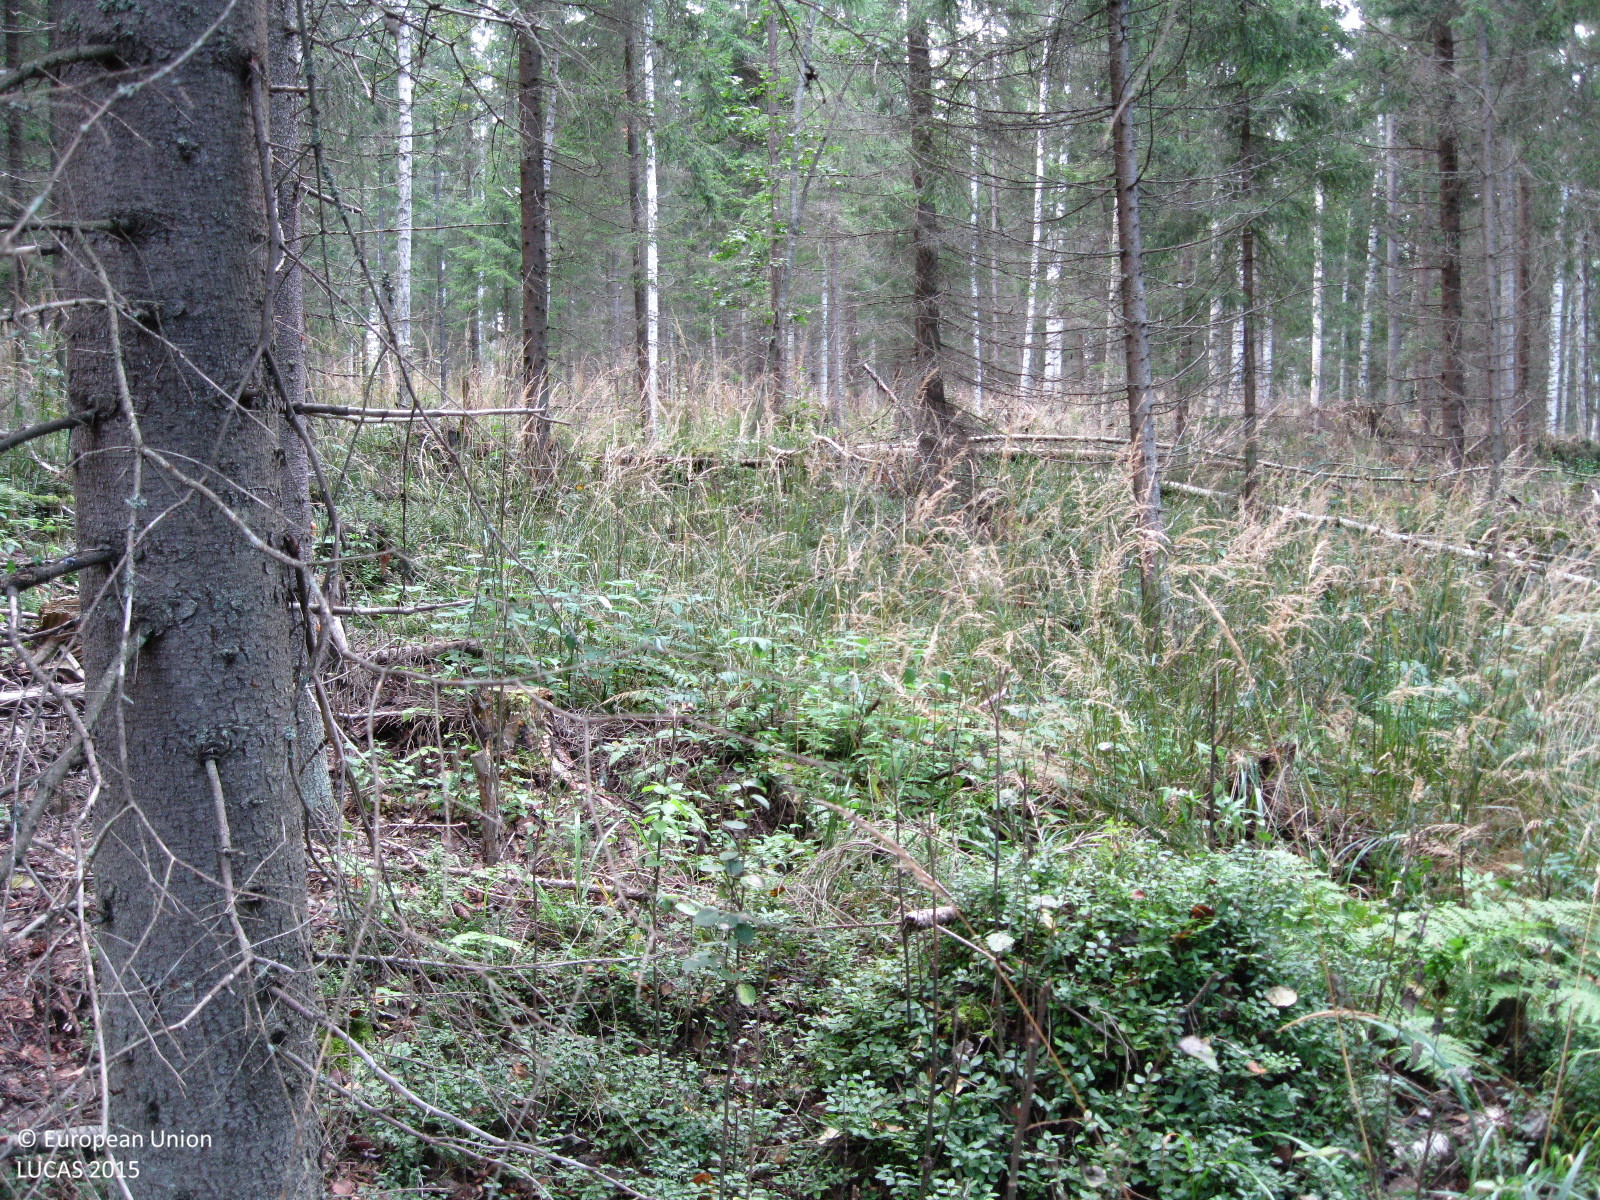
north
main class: Woodland
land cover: Spruce dominated mixed woodland
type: boreal forest
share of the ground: 50 - 75 %
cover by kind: coniferous forest trees 40 %, broadleaved forest trees 30 %, shrubs 20 %, herbaceous plants 10 %
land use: Forestry
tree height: > 5 m
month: September
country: FI
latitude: 60.6670
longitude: 24.9187
